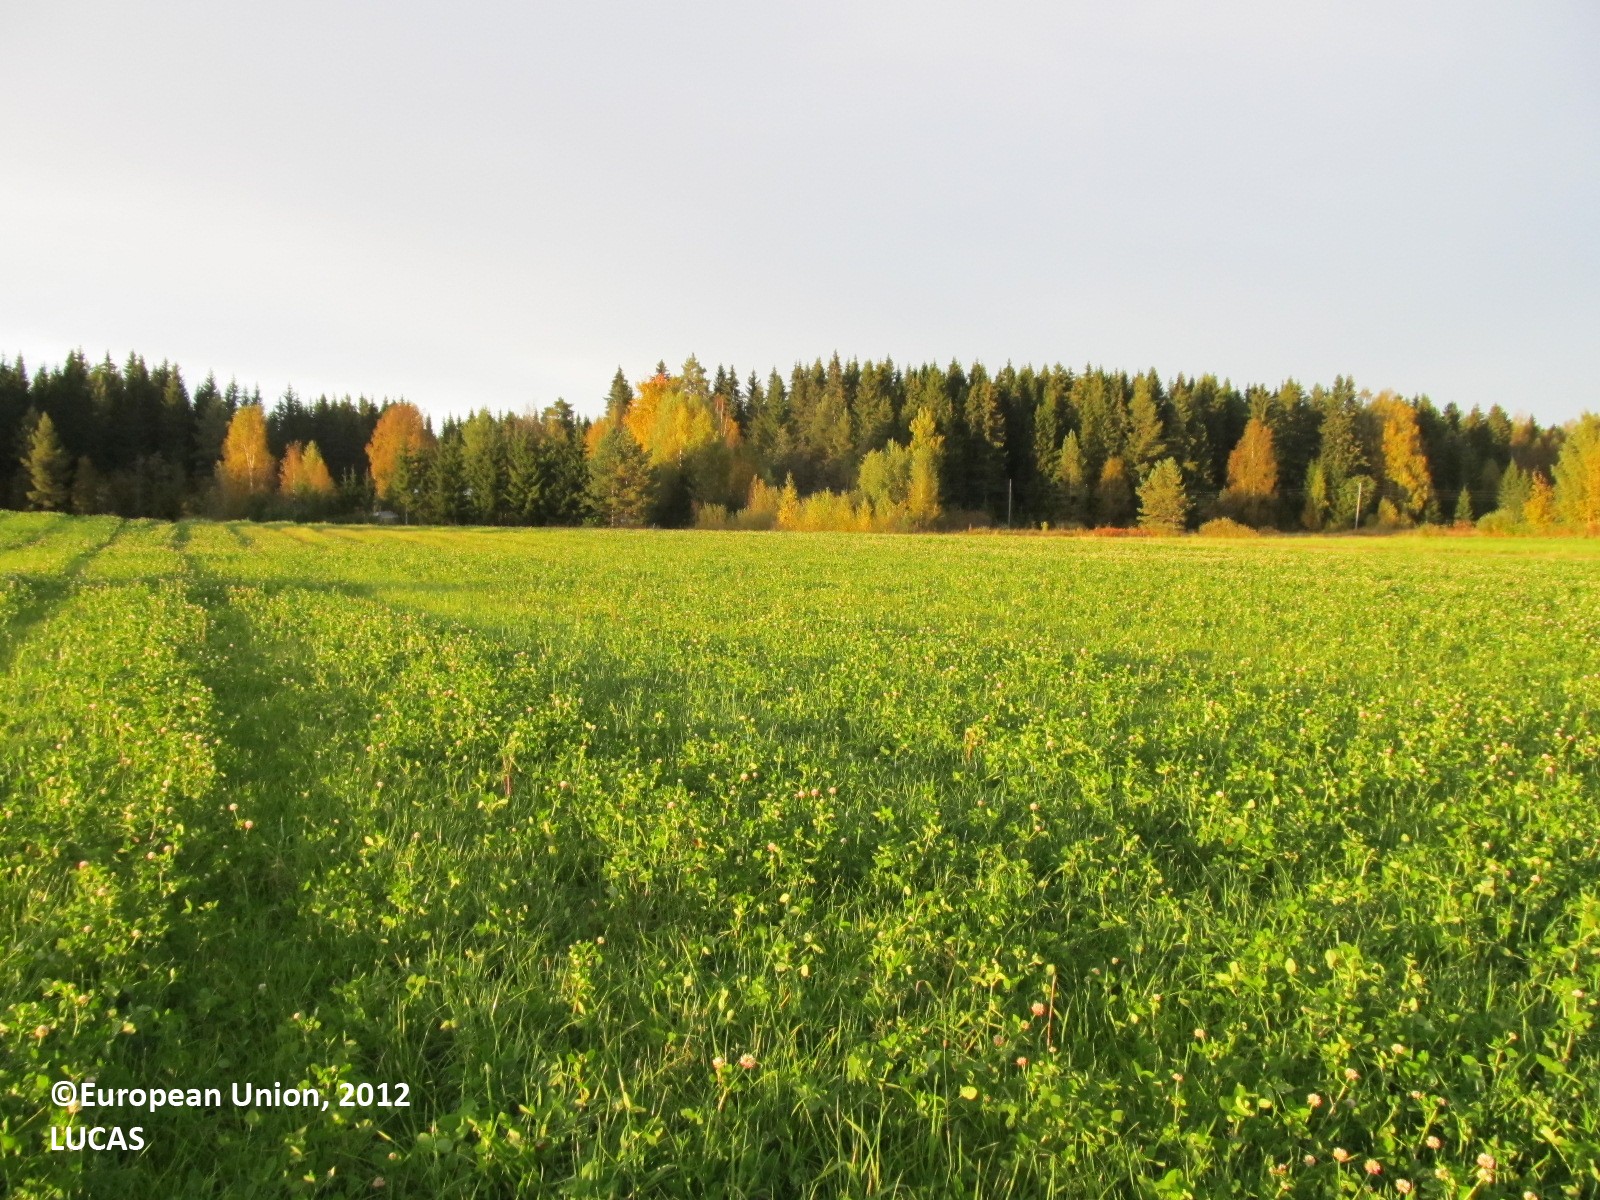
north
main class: Cropland
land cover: Clovers
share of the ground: > 75 %
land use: Agriculture (excluding fallow land and kitchen gardens)
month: September
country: FI
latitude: 62.7021
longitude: 28.3102
